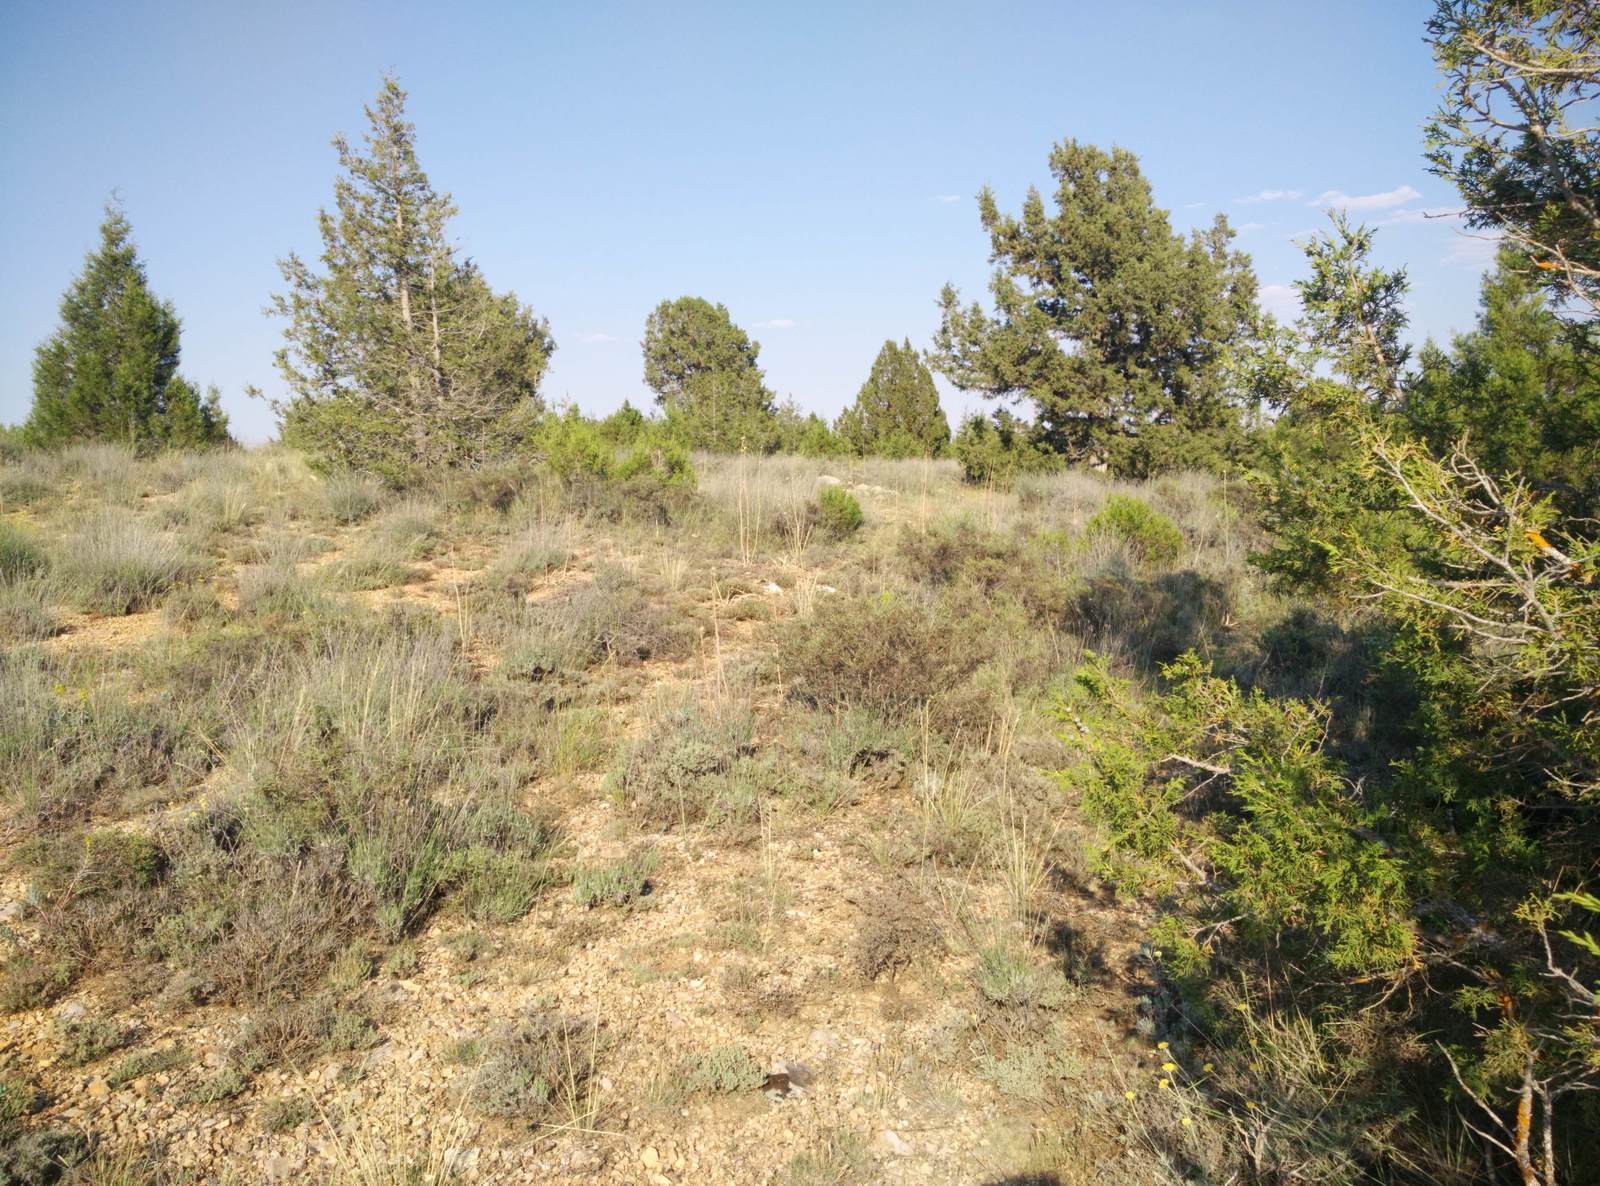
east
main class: Shrubland
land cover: Shrubland with sparse tree cover
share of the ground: 25 - 50 %
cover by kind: unconsolidated bare surface 50 %, shrubs 40 %, coniferous forest trees 5 %, herbaceous plants 5 %
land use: Semi-natural and natural areas not in use
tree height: > 5 m
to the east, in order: Shrubland with sparse tree cover; Rock outcrops; Shrubland with sparse tree cover; Tracks; Other coniferous woodland; Rocks and stones; Grassland with sparse tree/shrub cover
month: June
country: ES
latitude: 40.7757
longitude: -1.9534
